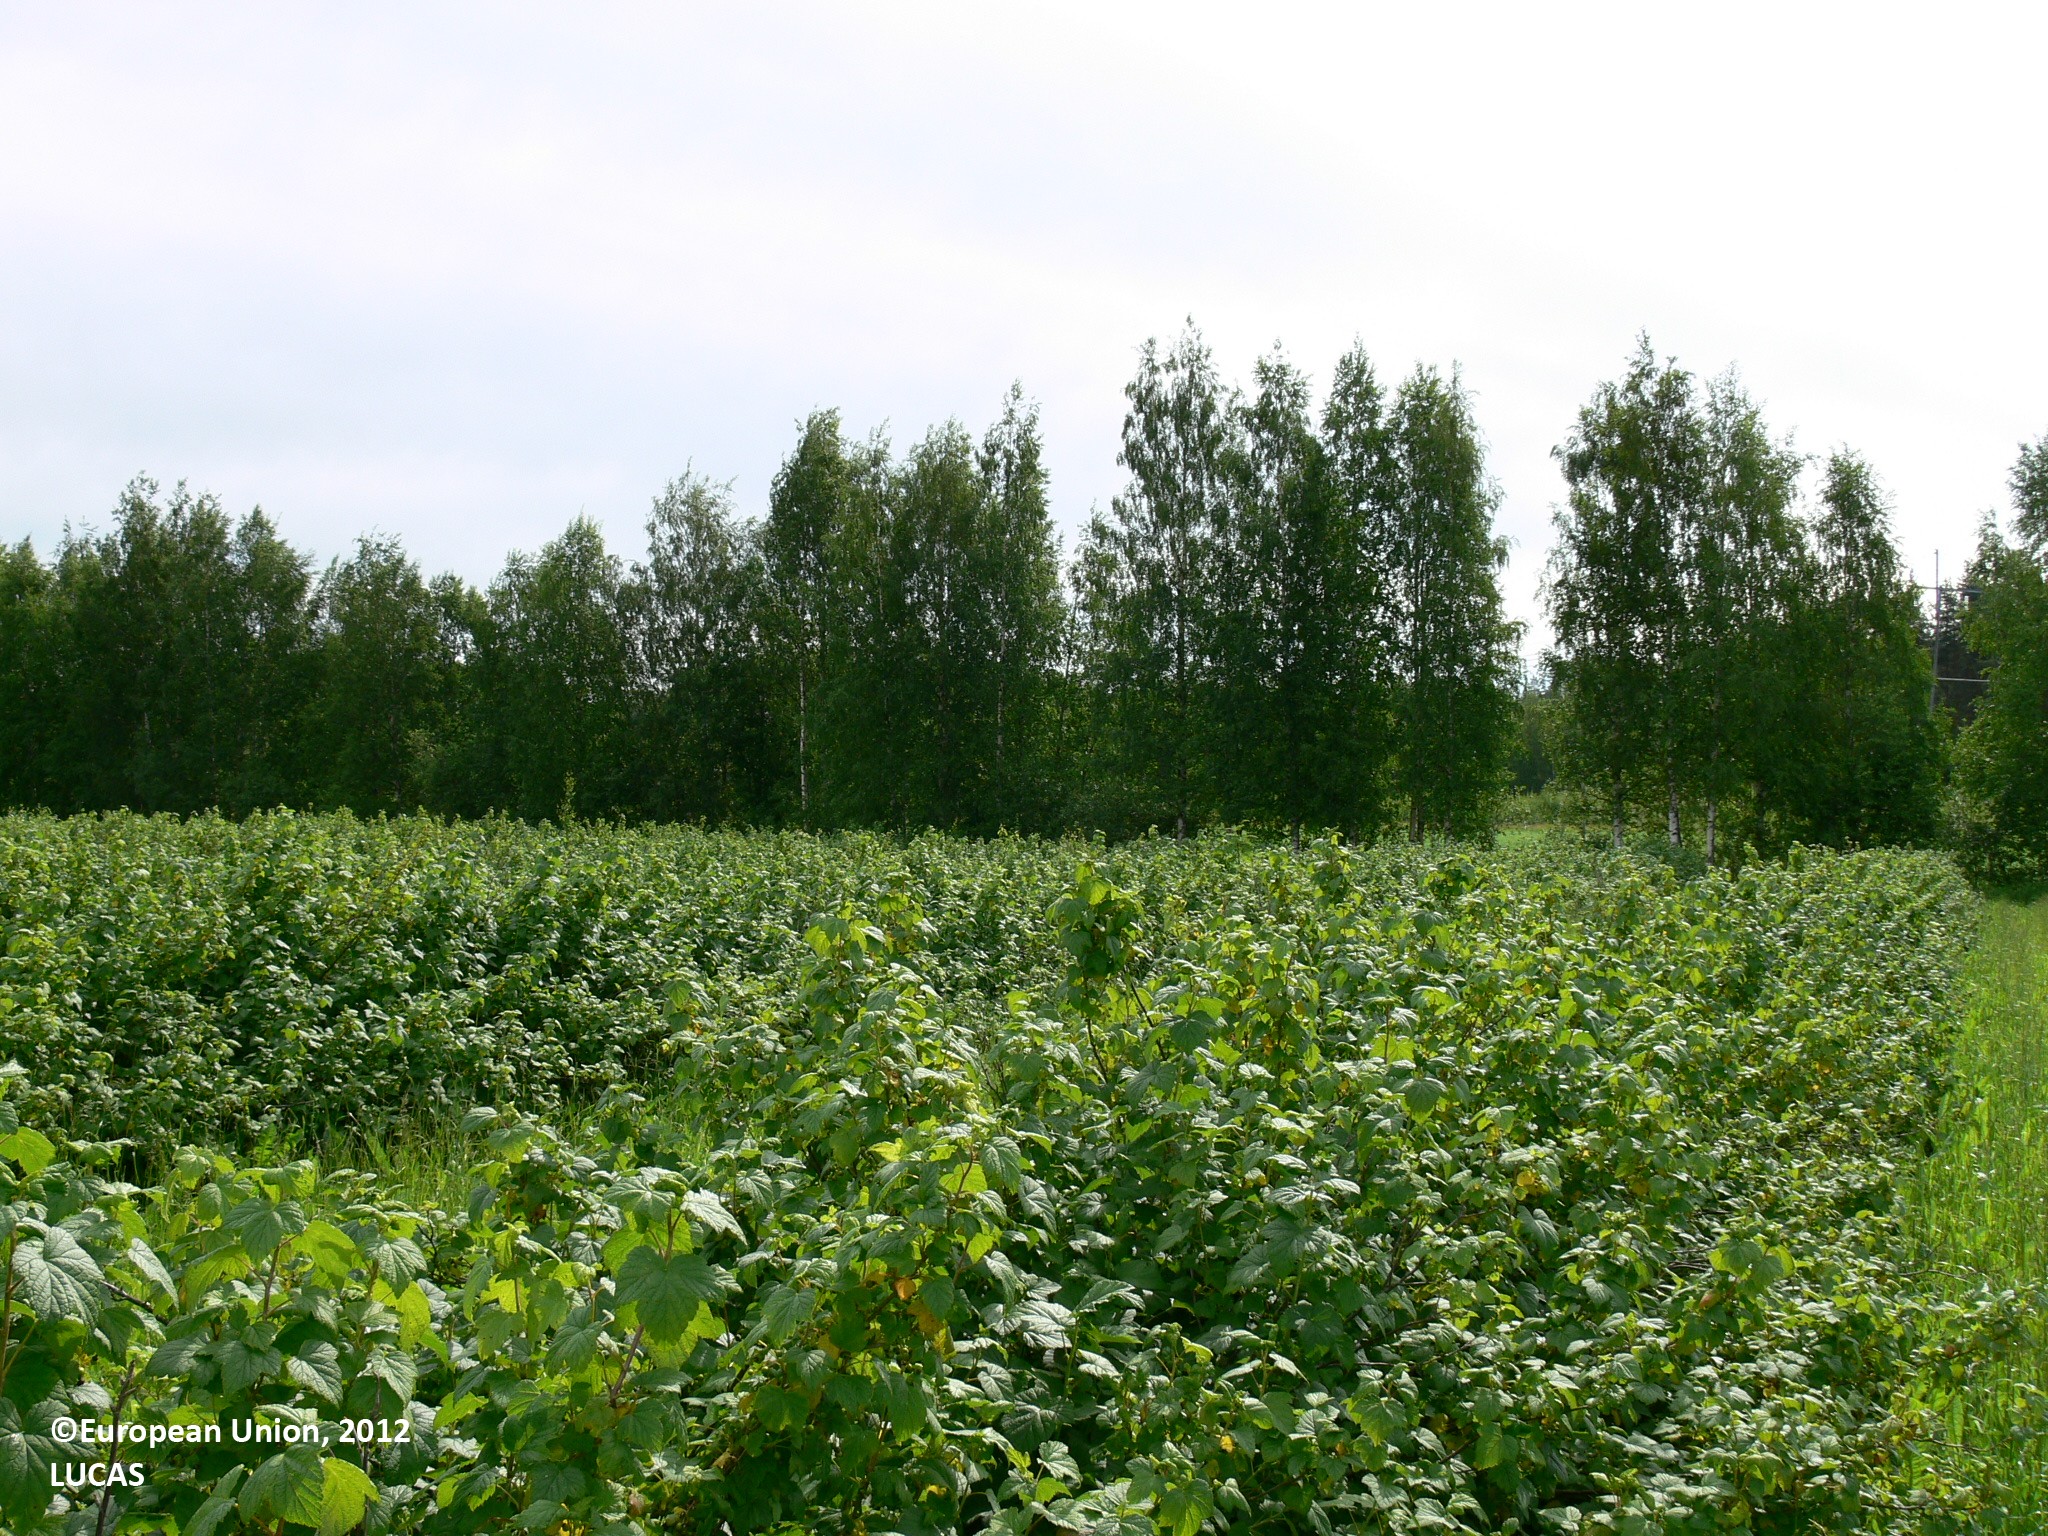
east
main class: Cropland
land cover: Other fruit trees and berries
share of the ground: 25 - 50 %
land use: Agriculture (excluding fallow land and kitchen gardens)
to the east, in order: Other fruit trees and berries; Grass margins; Broadleaved woodland; Ditches and canals; Broadleaved woodland; Grass margins; Barley
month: June
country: FI
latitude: 62.6445
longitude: 29.4908
